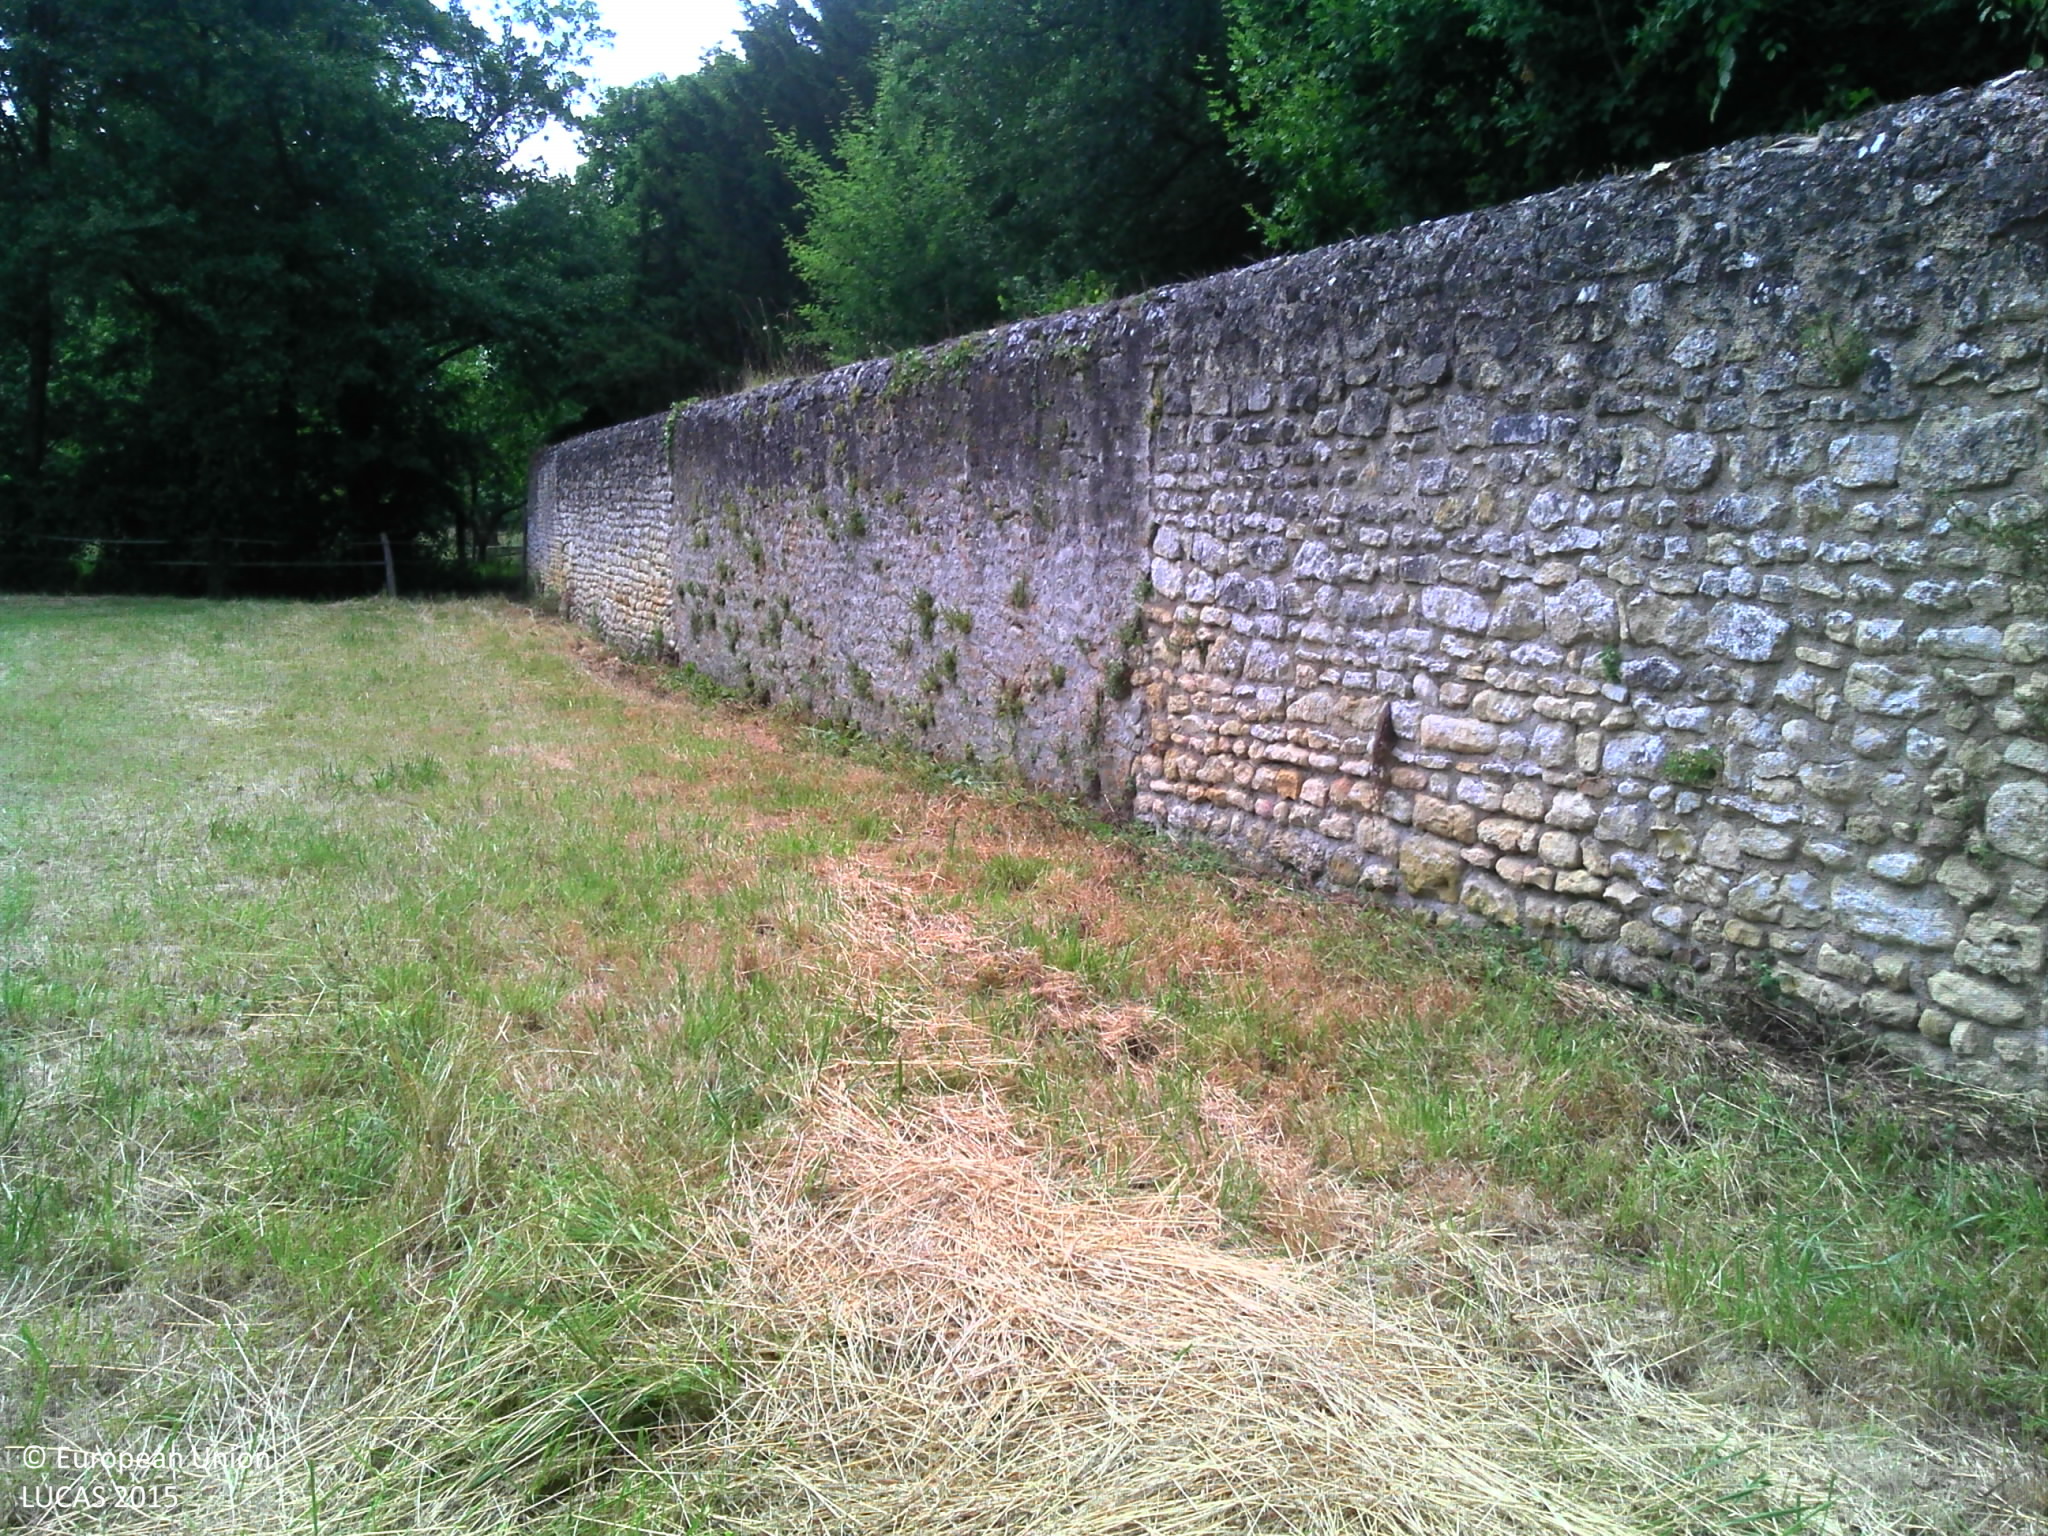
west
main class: Grassland
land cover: Grassland with sparse tree/shrub cover
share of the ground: > 75 %
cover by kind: herbaceous plants 95 %, broadleaved forest trees 5 %
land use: Residential
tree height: > 5 m
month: June
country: FR
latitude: 47.0818
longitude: 1.0677
